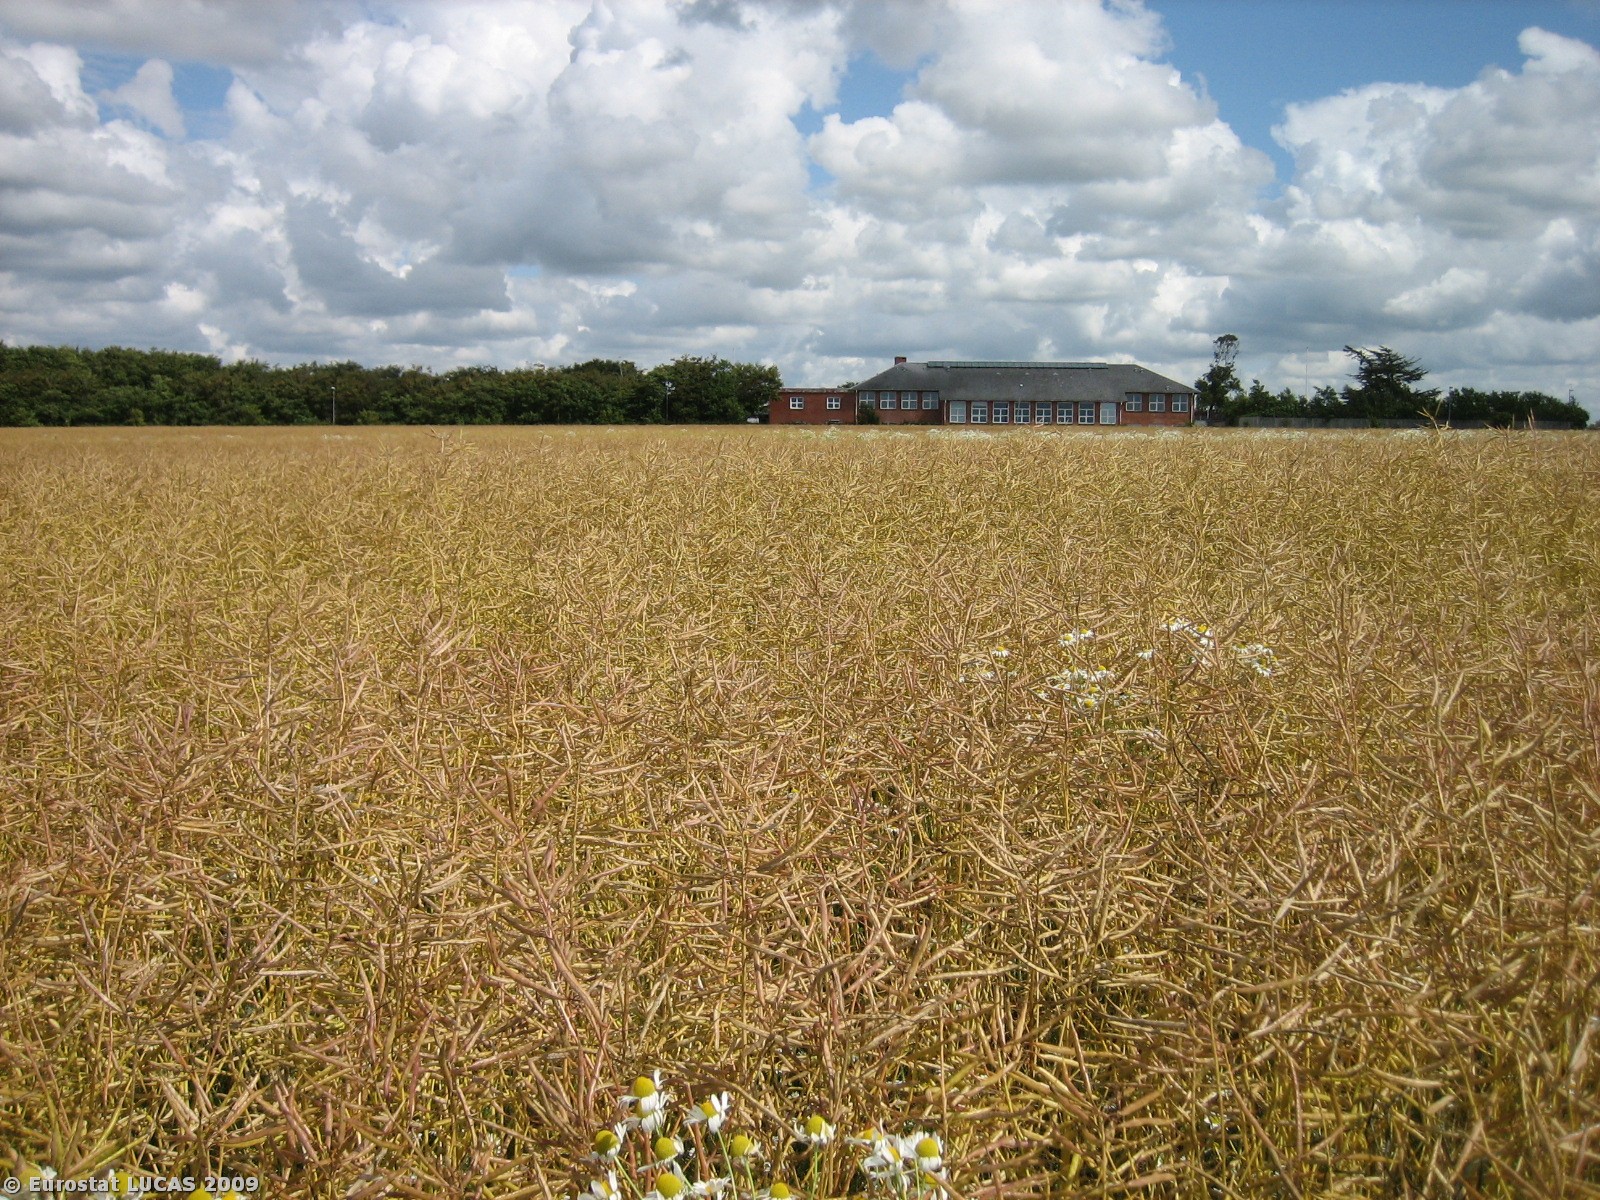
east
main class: Cropland
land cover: Rape and turnip rape
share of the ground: > 75 %
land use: Agriculture (excluding fallow land and kitchen gardens)
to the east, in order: Rape and turnip rape; Abandoned hedges; Artificial constructions in urban areas; Paved roads, cycling and walking lanes; Artificial constructions in urban areas; Managed hedges; Artificial constructions in urban areas; Grassland without tree/shrub cover
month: July
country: DK
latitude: 55.8013
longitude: 8.4860
